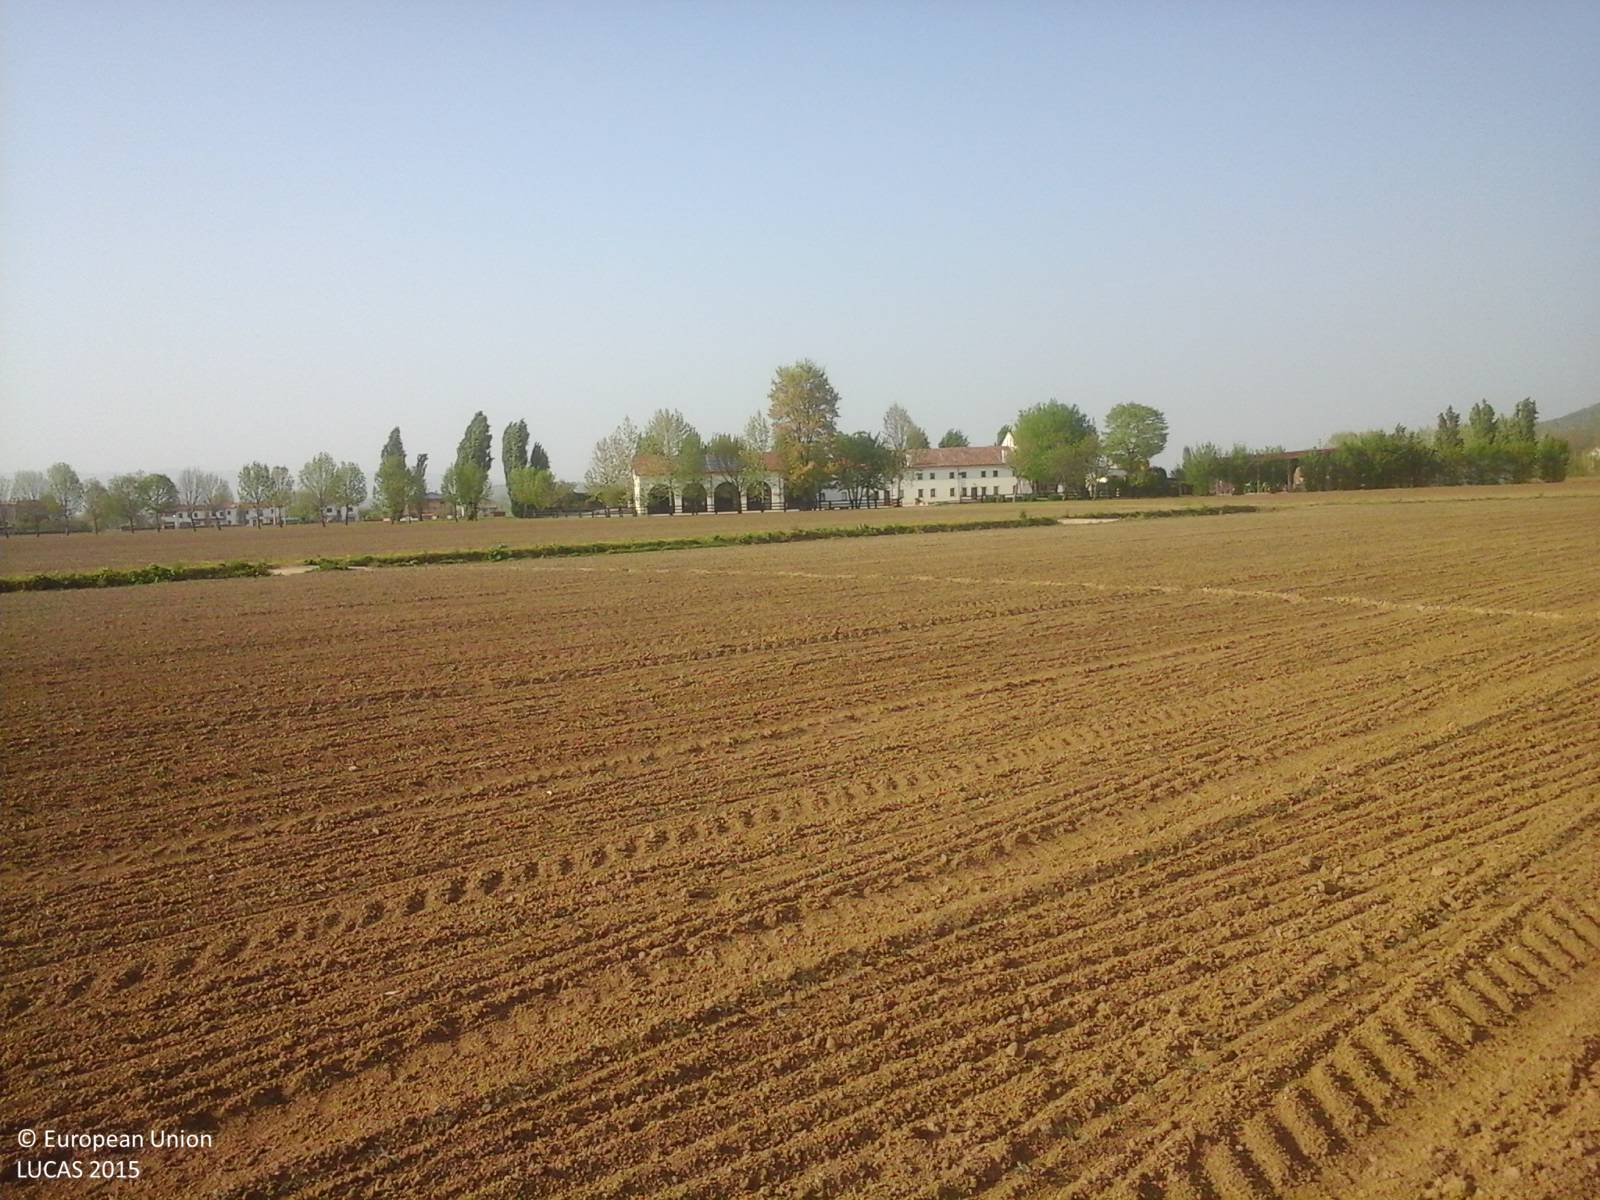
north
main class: Cropland
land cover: Tomatoes
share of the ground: < 10 %
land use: Agriculture (excluding fallow land and kitchen gardens)
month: April
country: IT
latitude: 45.3302
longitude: 11.5922
